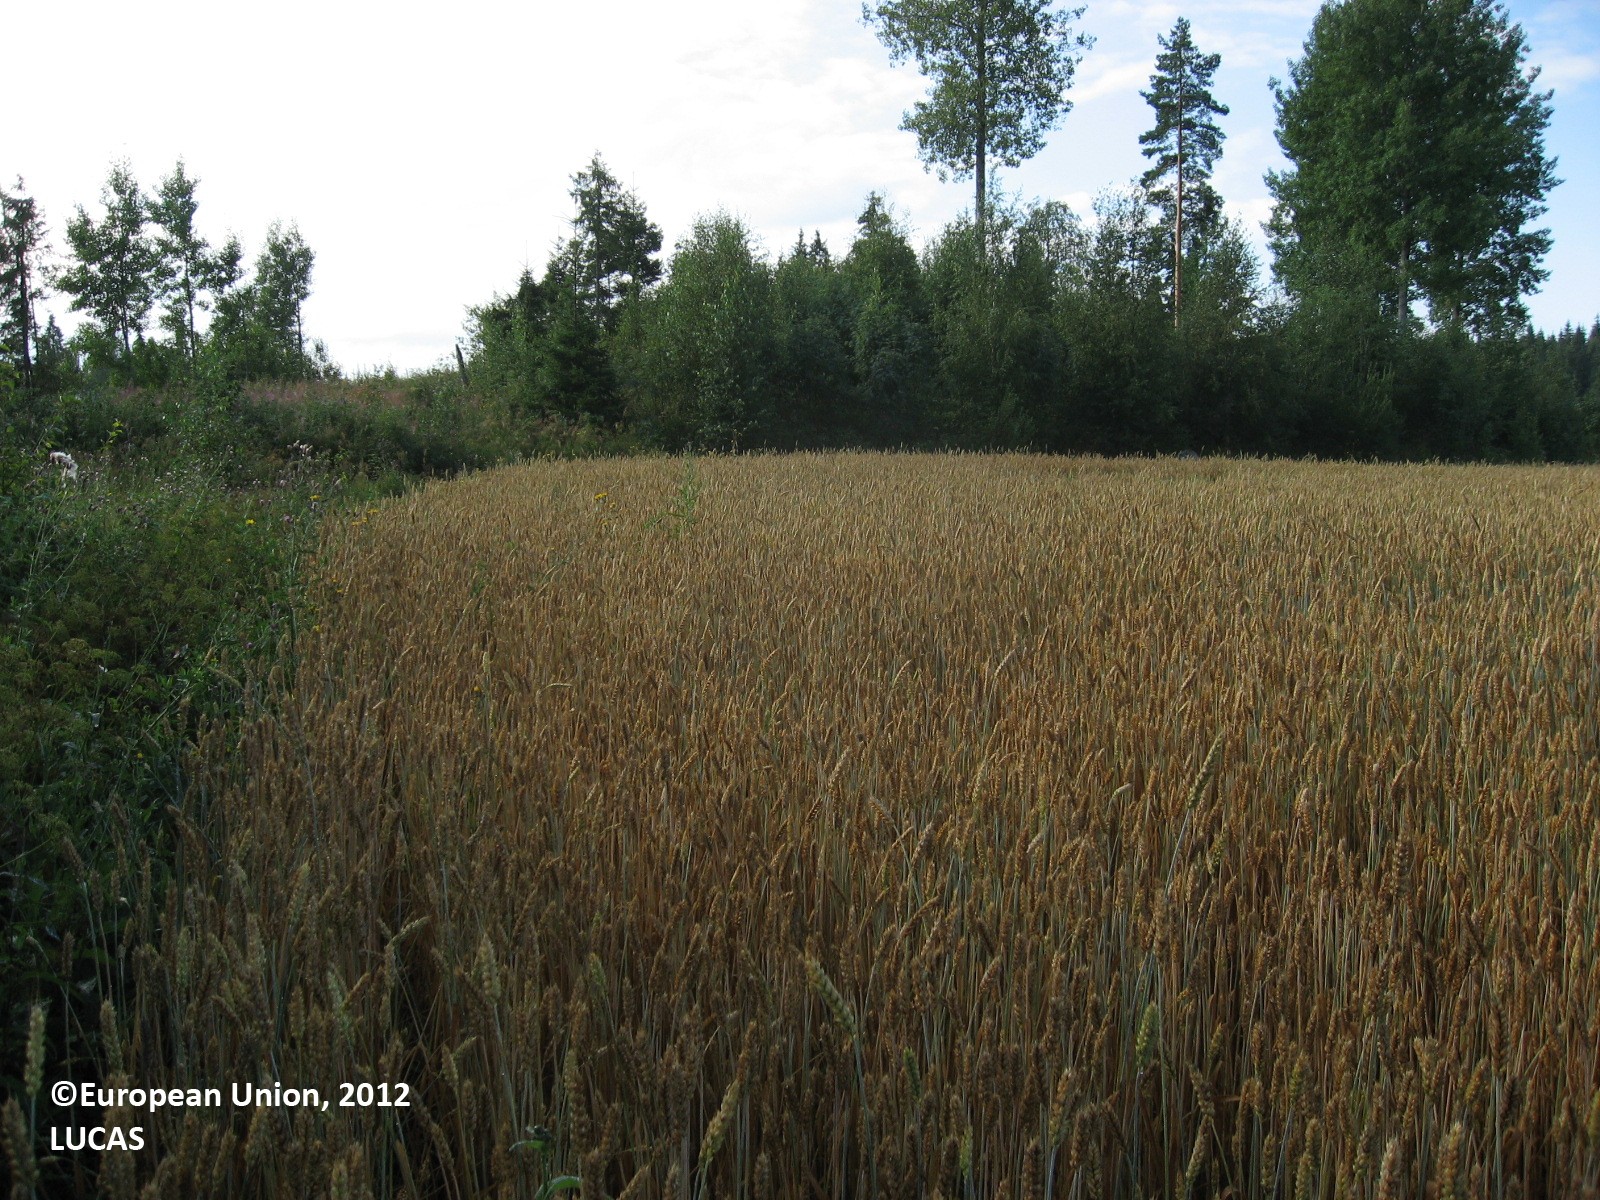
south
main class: Cropland
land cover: Common wheat
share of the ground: > 75 %
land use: Agriculture (excluding fallow land and kitchen gardens)
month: August
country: FI
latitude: 60.6404
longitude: 25.1685
